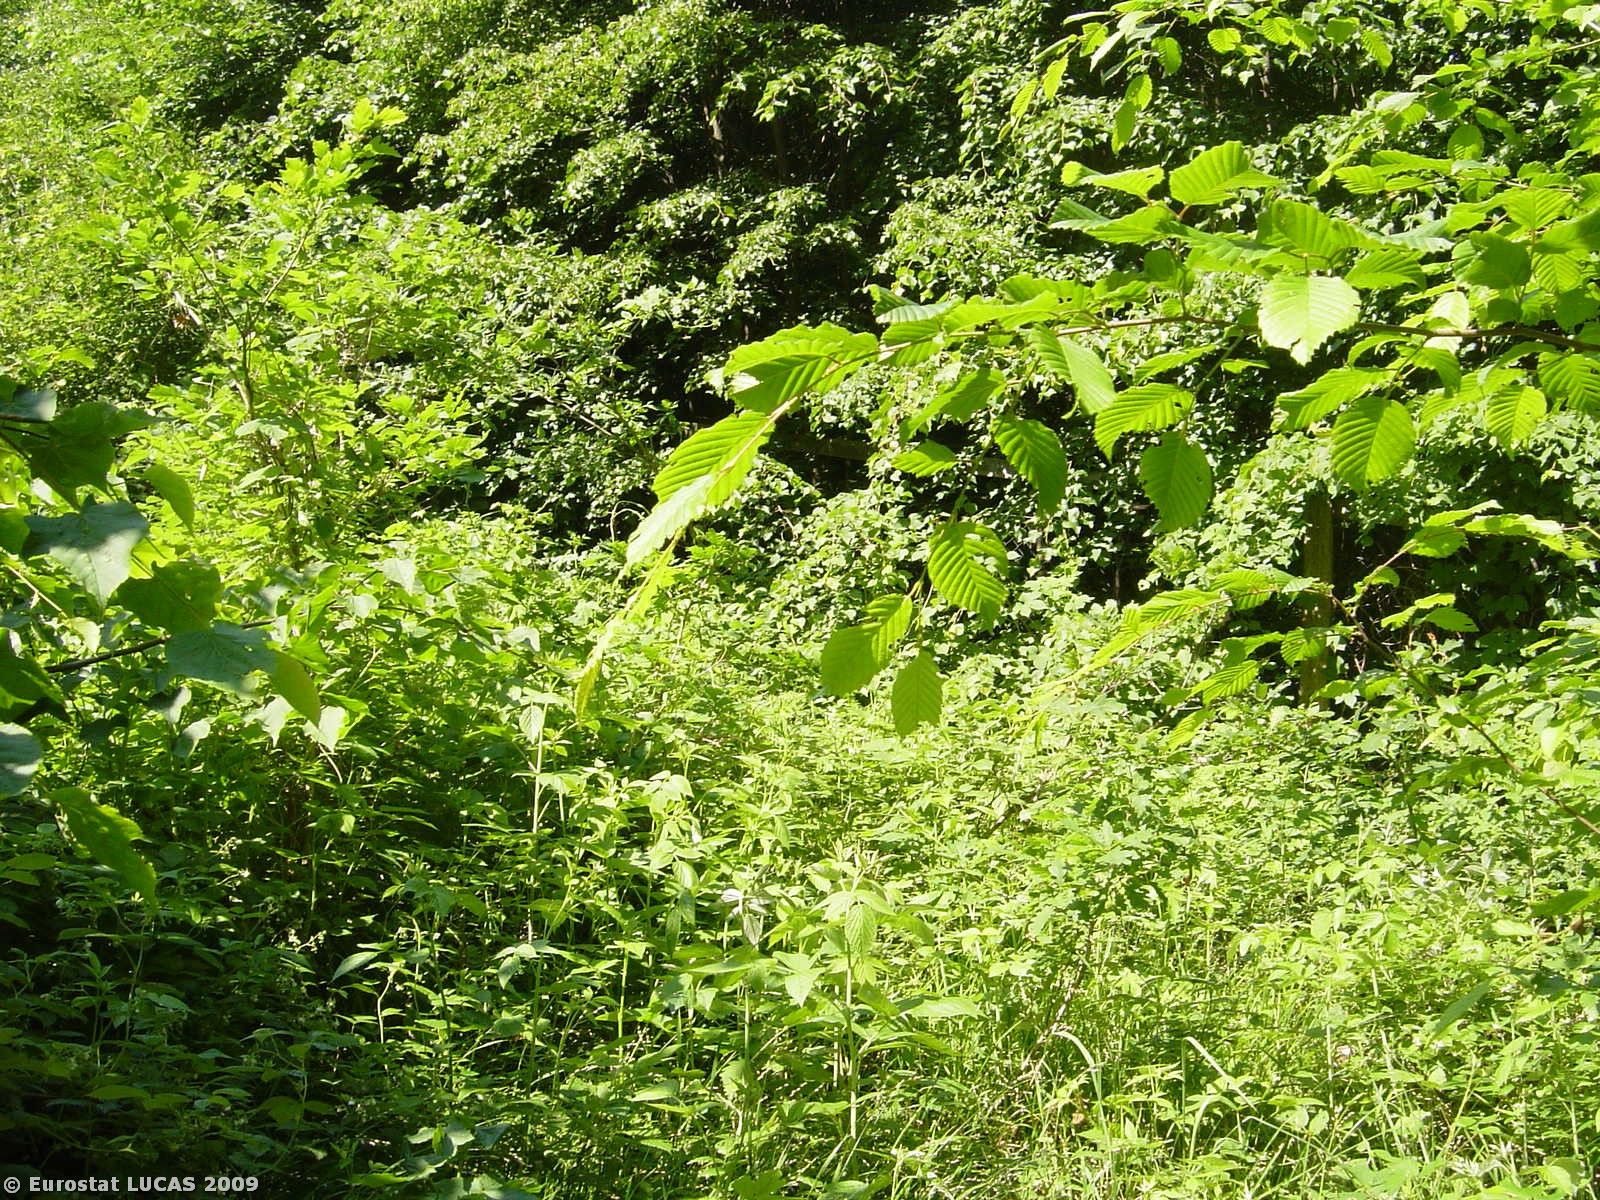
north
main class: Woodland
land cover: Broadleaved woodland
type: mesophytic deciduous forest
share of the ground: > 75 %
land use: Forestry
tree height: > 5 m
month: May
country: CZ
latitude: 49.0772
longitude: 17.1147
